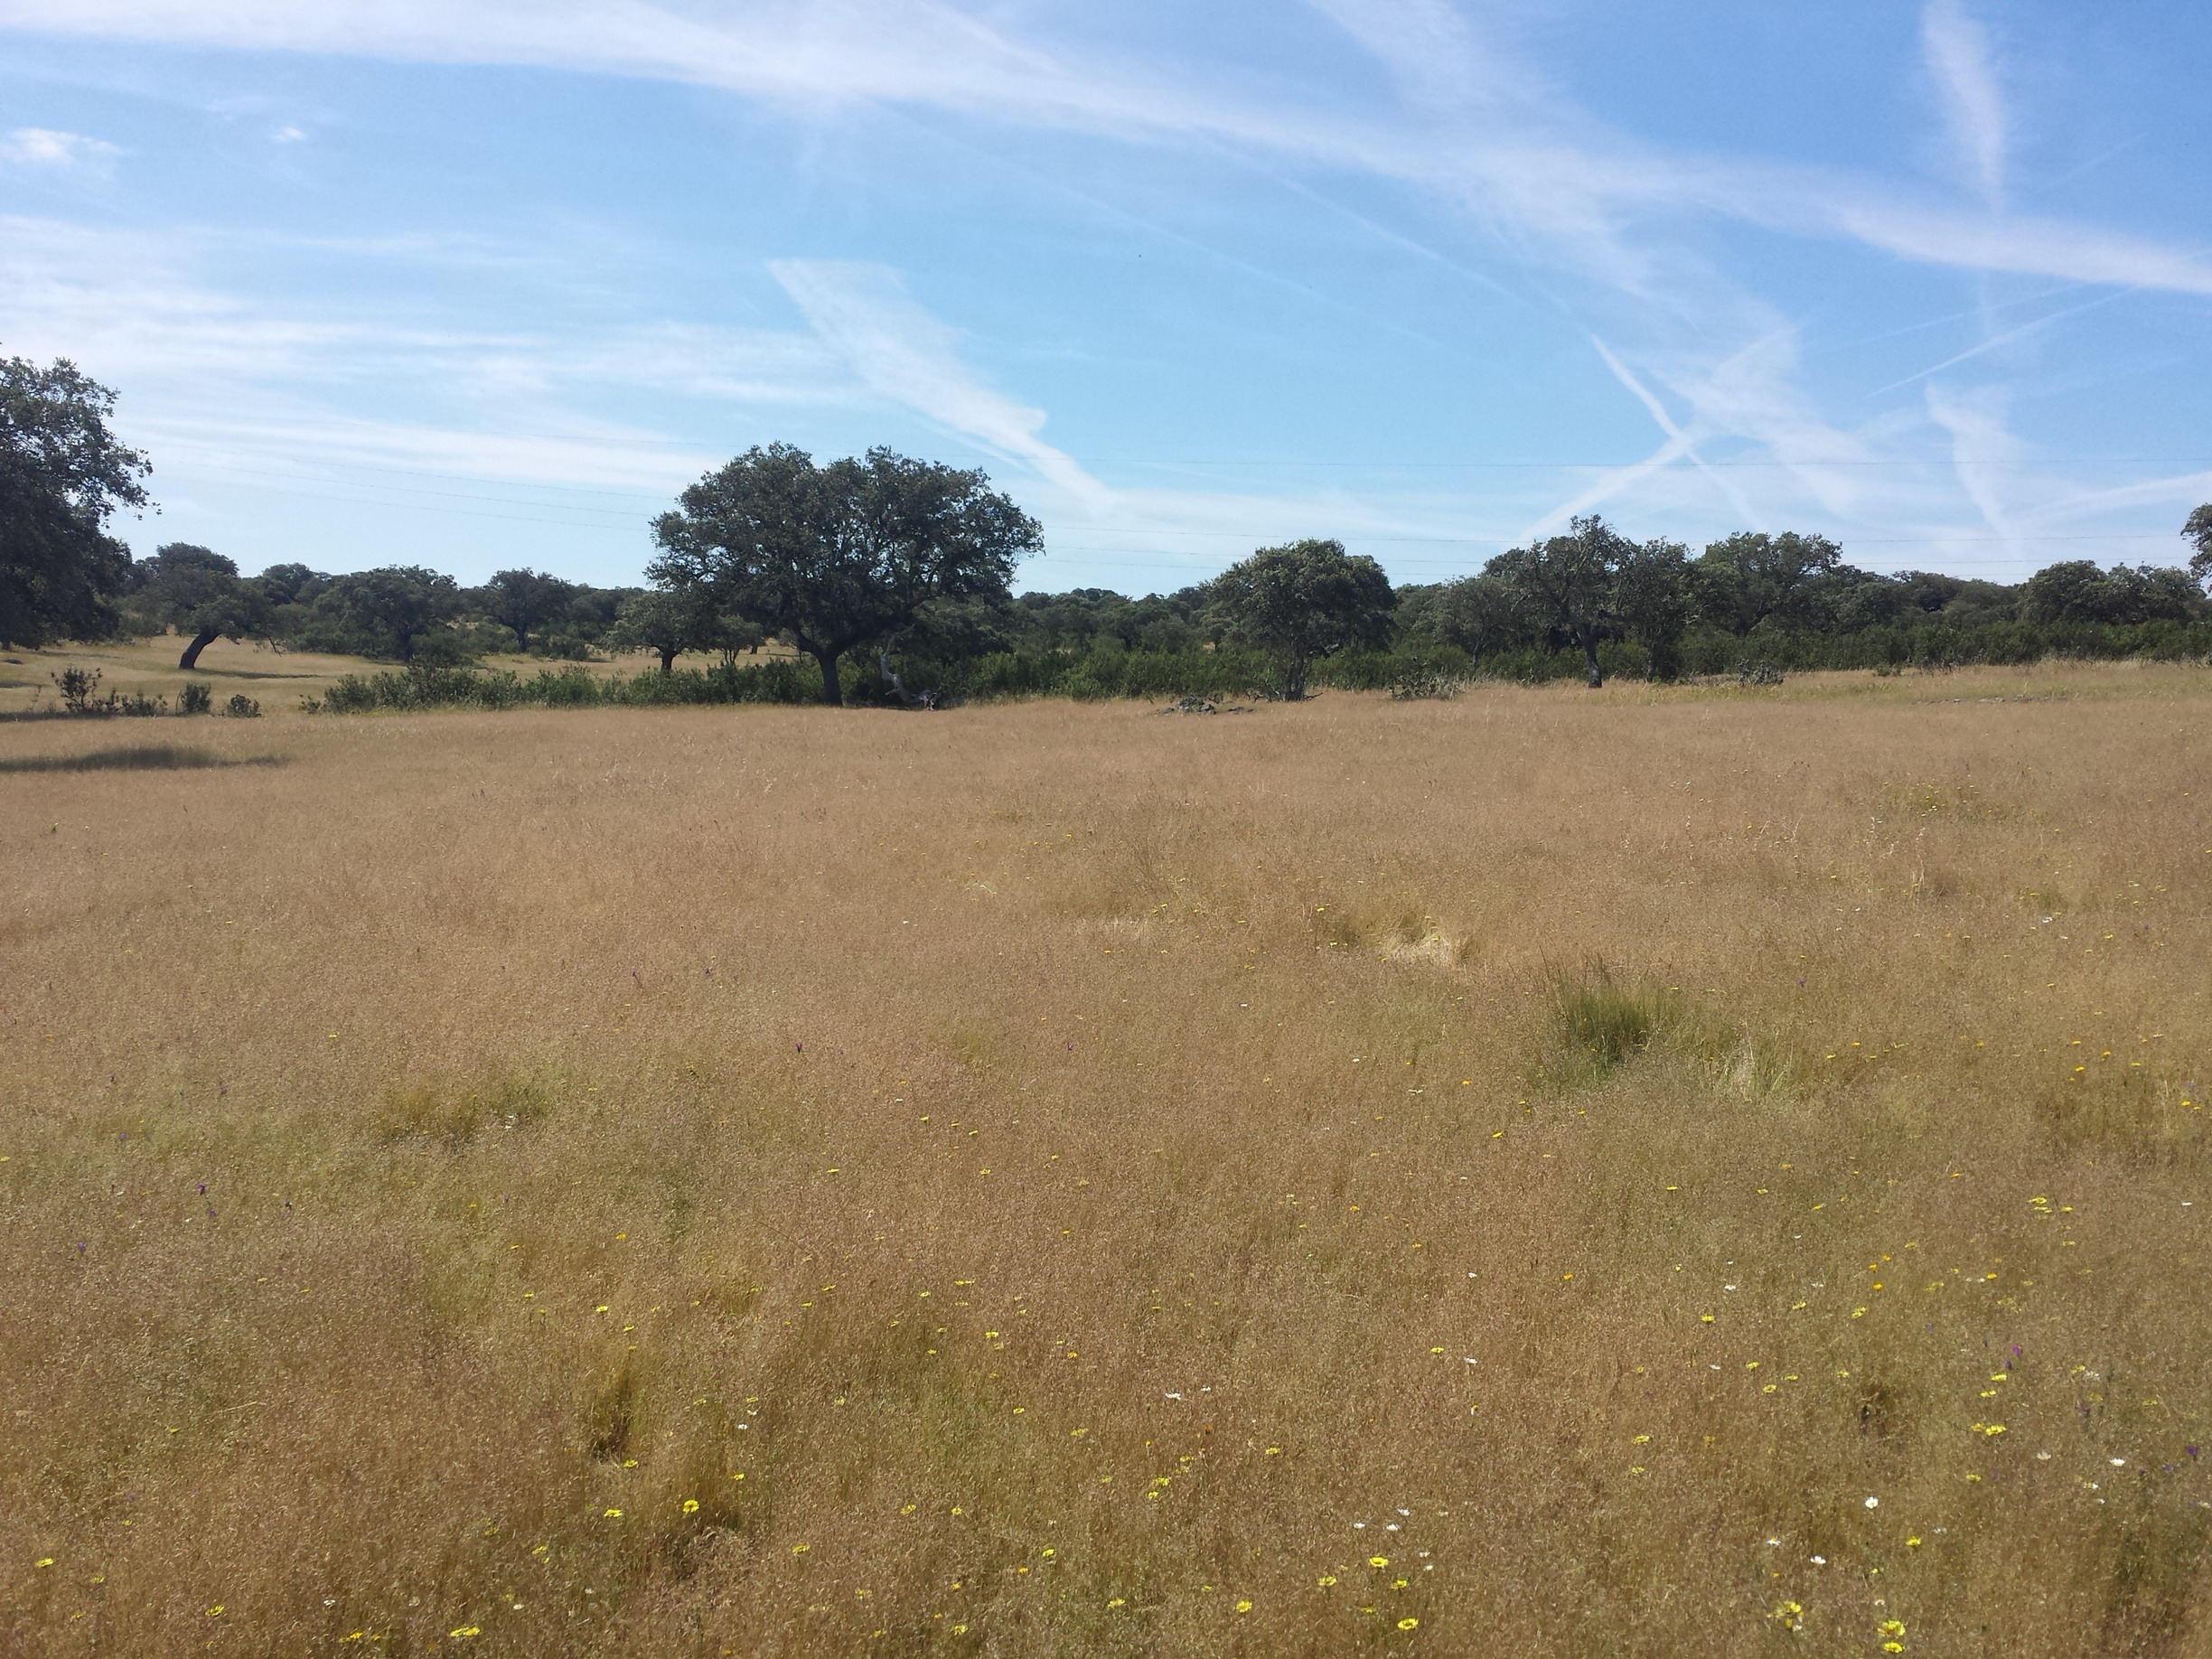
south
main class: Grassland
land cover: Grassland without tree/shrub cover
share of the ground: > 75 %
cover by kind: herbaceous plants 100 %
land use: Agriculture (excluding fallow land and kitchen gardens)
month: May
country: ES
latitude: 39.6154
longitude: -7.1280
